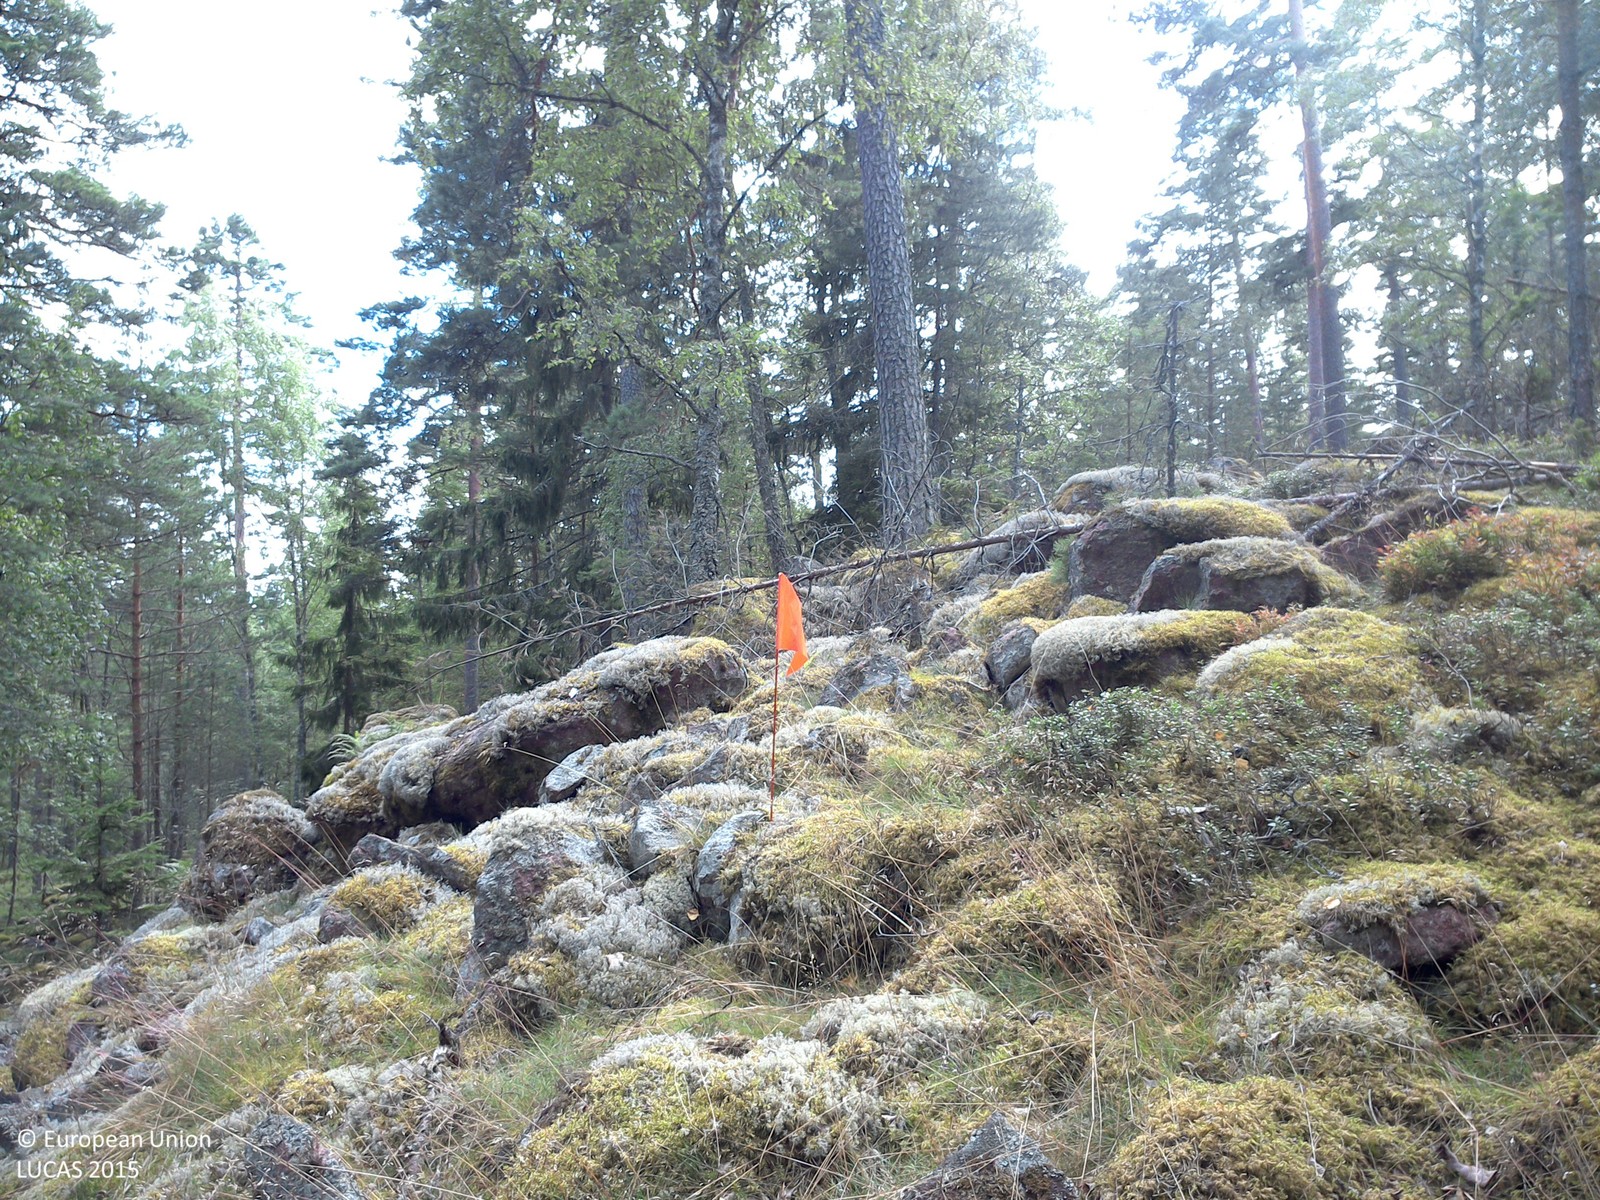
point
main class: Woodland
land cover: Pine dominated coniferous woodland
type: boreal forest
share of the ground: 25 - 50 %
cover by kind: lichens and mosses 50 %, coniferous forest trees 40 %, herbaceous plants 10 %
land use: Forestry
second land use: Amenities, museums, leisure
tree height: > 5 m
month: August
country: SE
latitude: 58.1456
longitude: 14.9721
